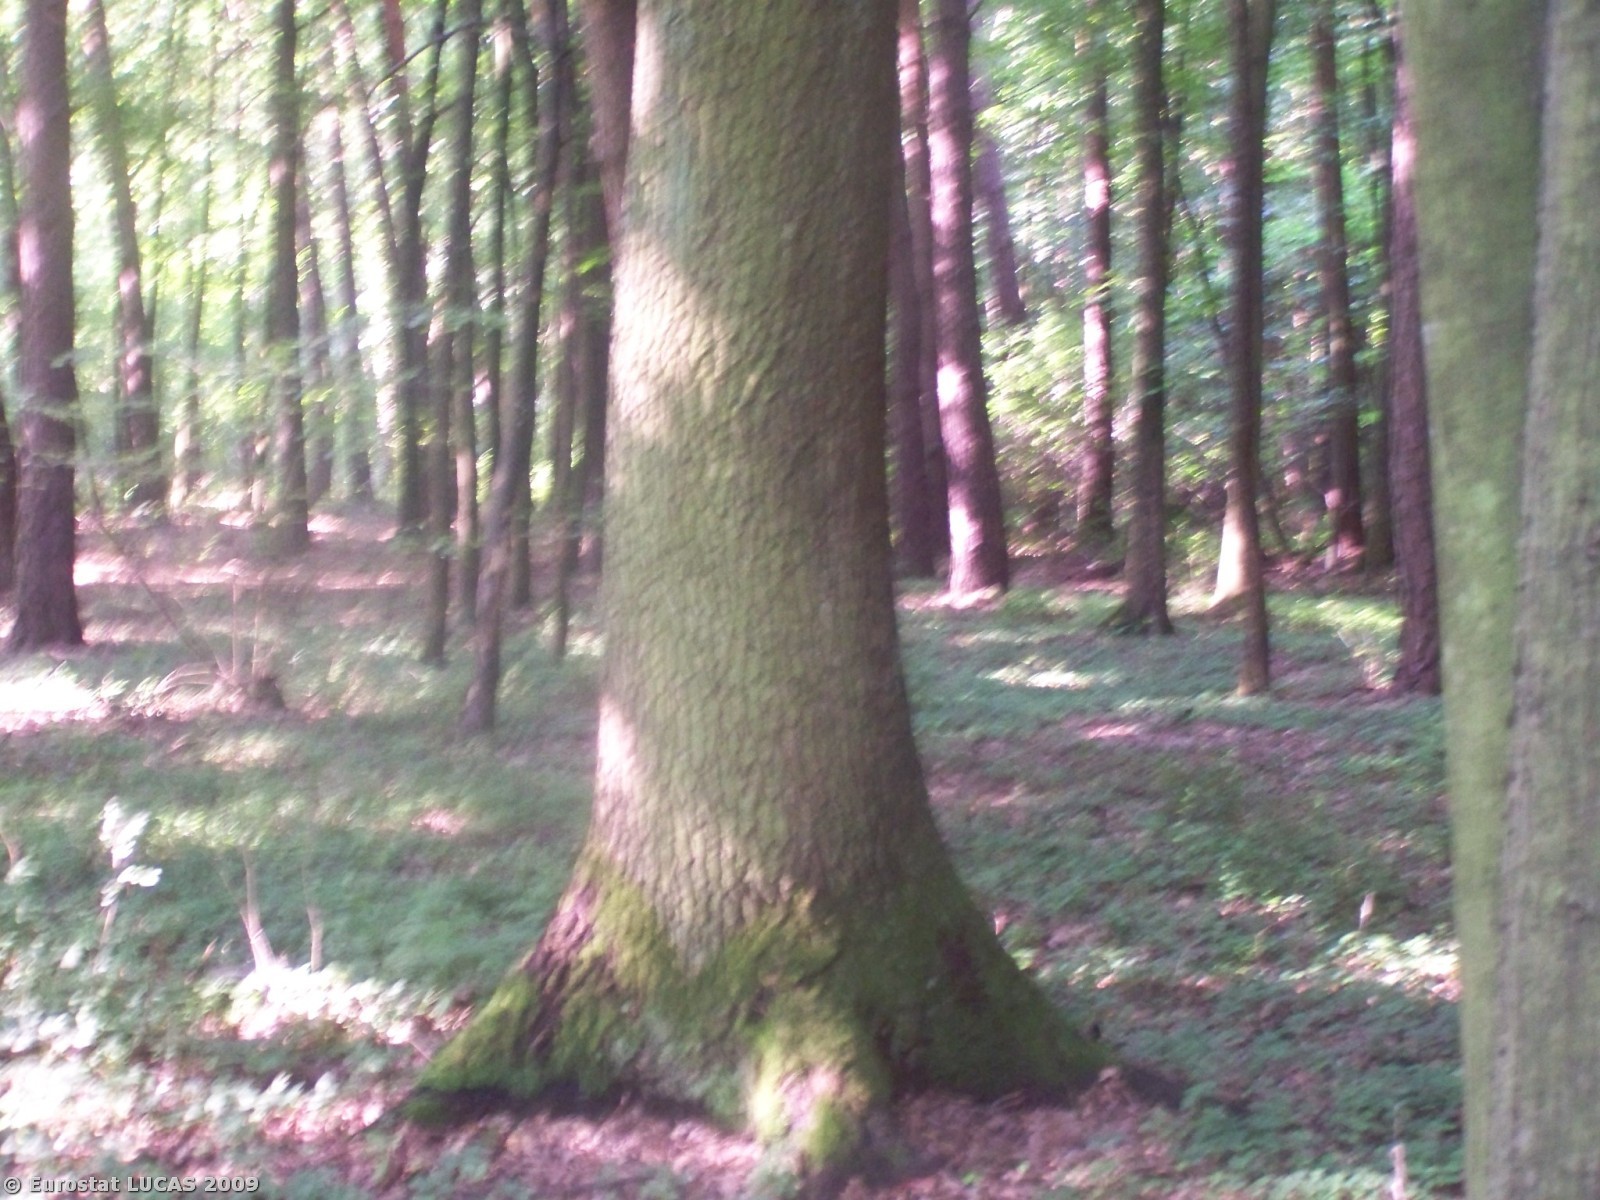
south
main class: Woodland
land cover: Broadleaved woodland
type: mesophytic deciduous forest
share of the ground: > 75 %
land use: Forestry
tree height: > 5 m
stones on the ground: < 10 %
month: July
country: PL
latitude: 51.9351
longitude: 21.5863
